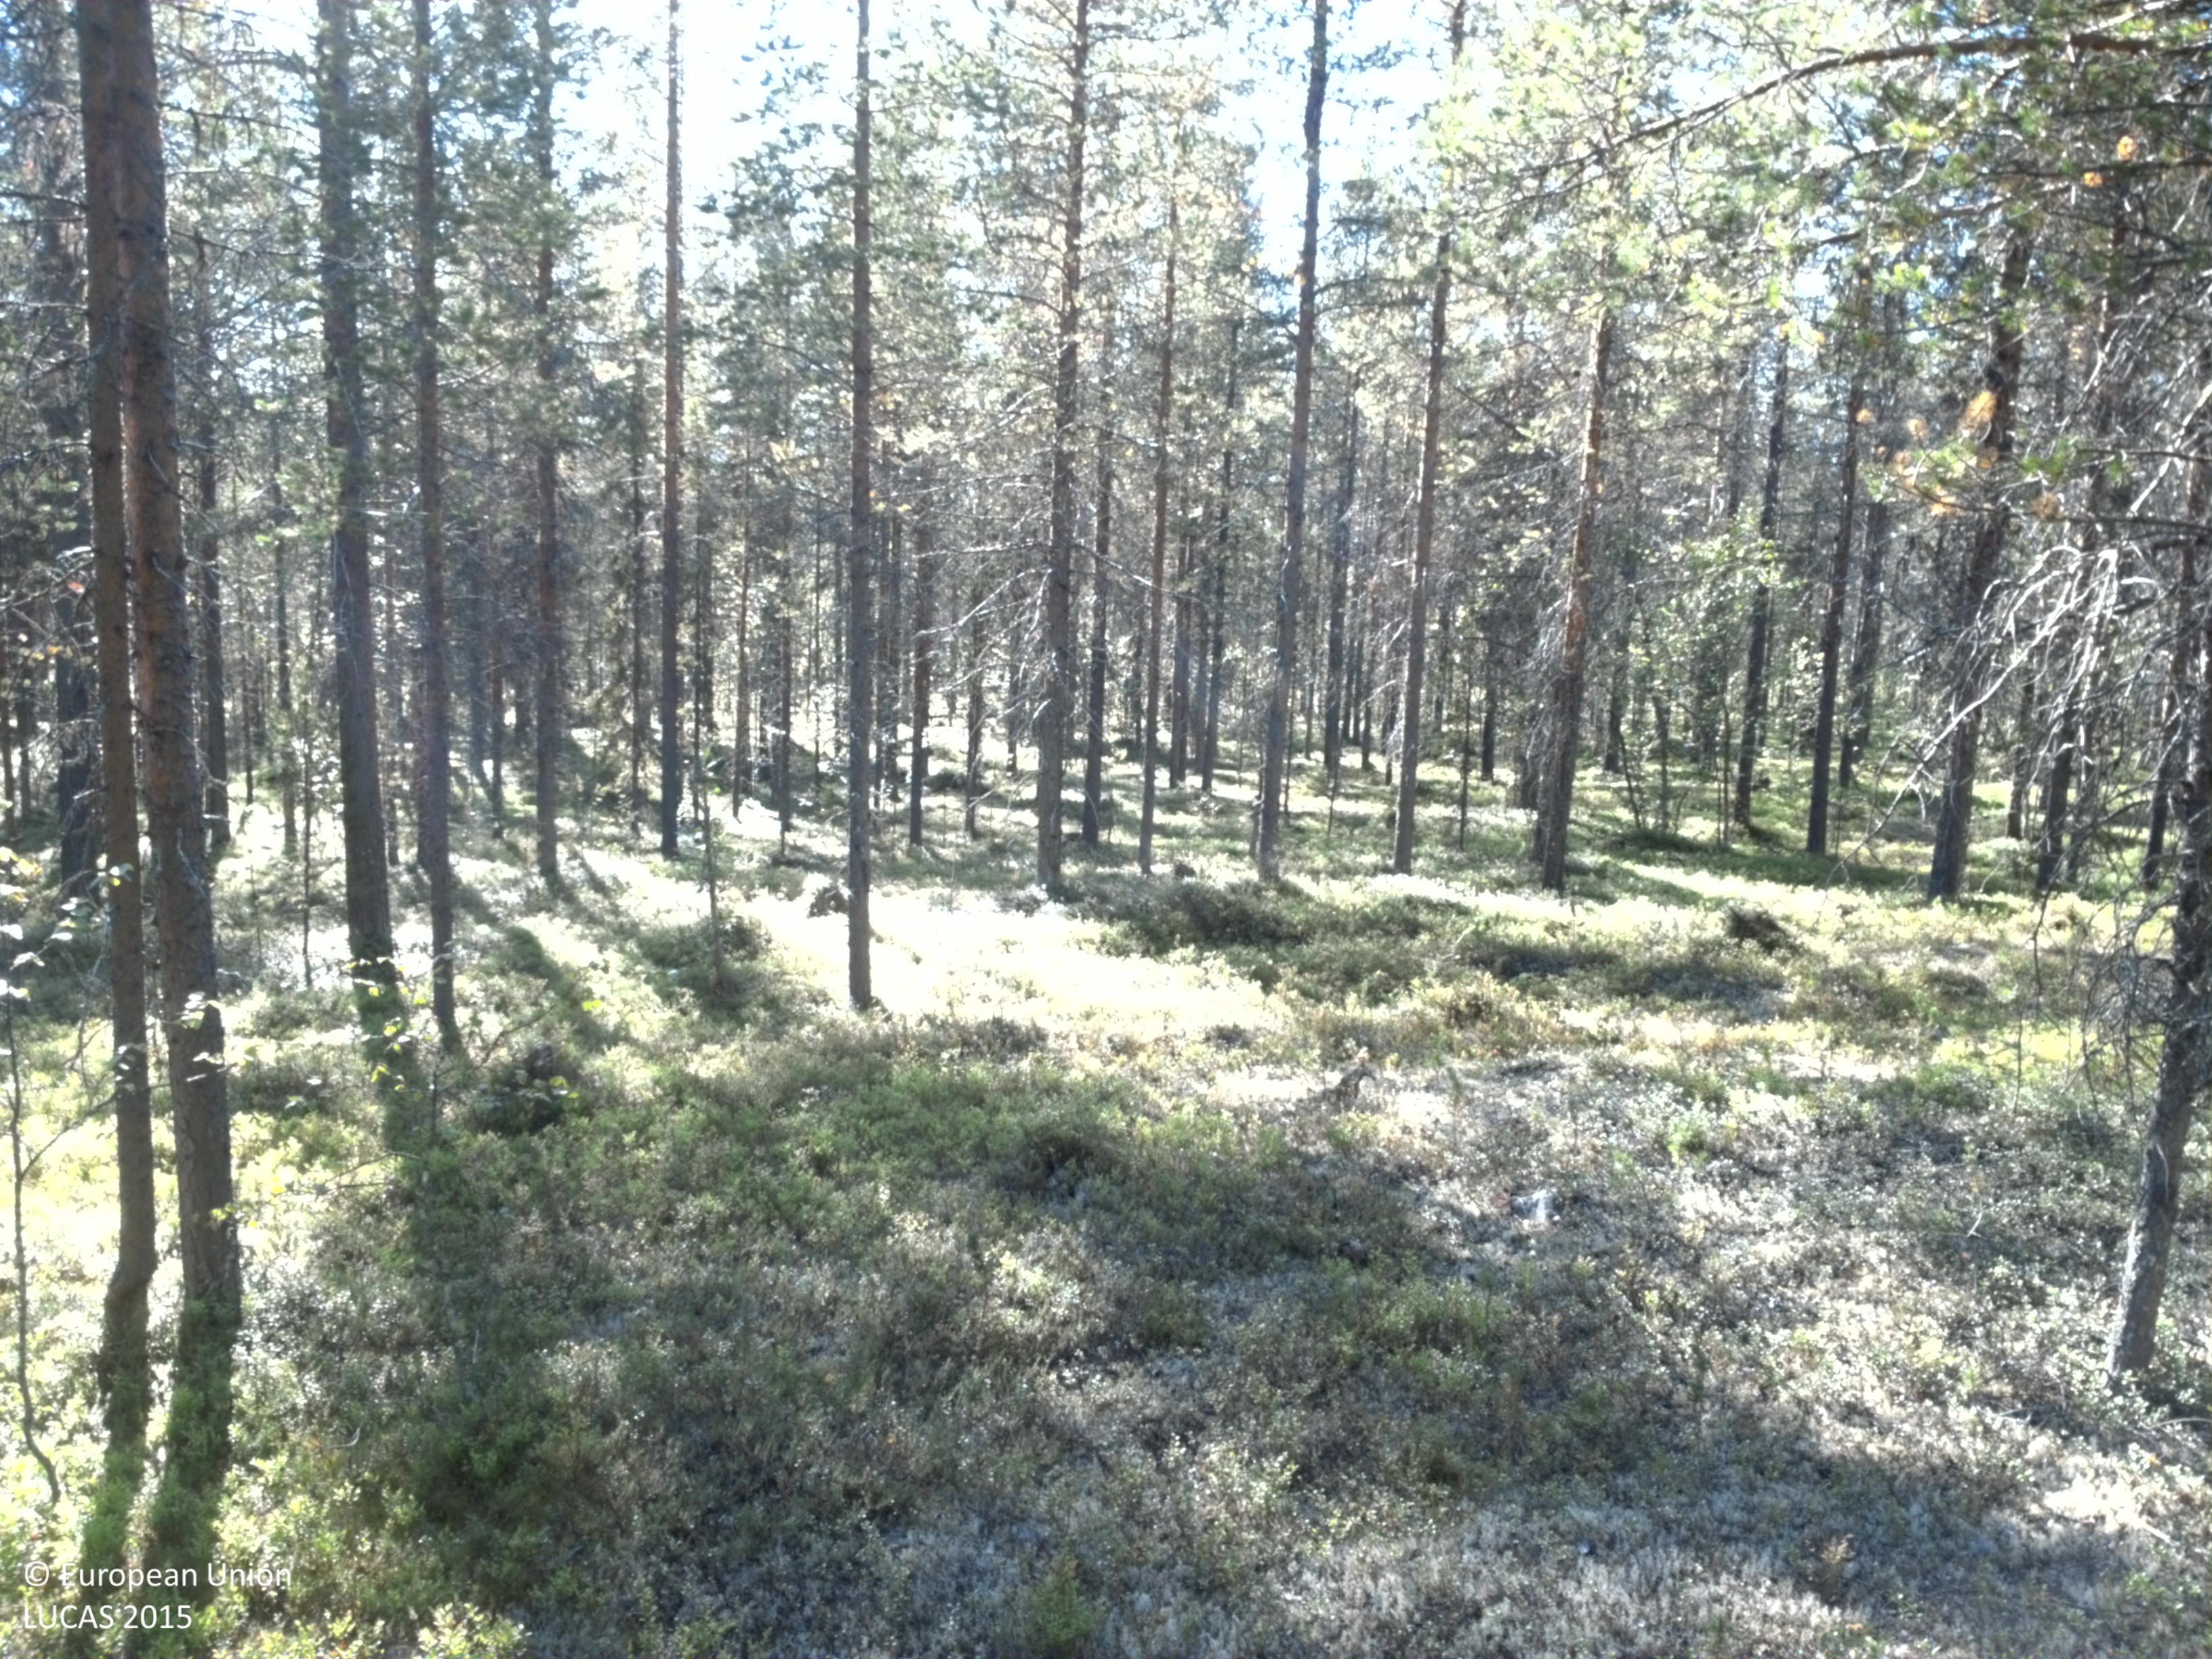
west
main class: Woodland
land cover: Pine dominated coniferous woodland
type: boreal forest
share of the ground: 25 - 50 %
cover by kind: shrubs 60 %, coniferous forest trees 40 %
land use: Forestry
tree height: > 5 m
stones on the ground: 10 - 25 %
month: August
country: SE
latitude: 66.6241
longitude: 18.9170
